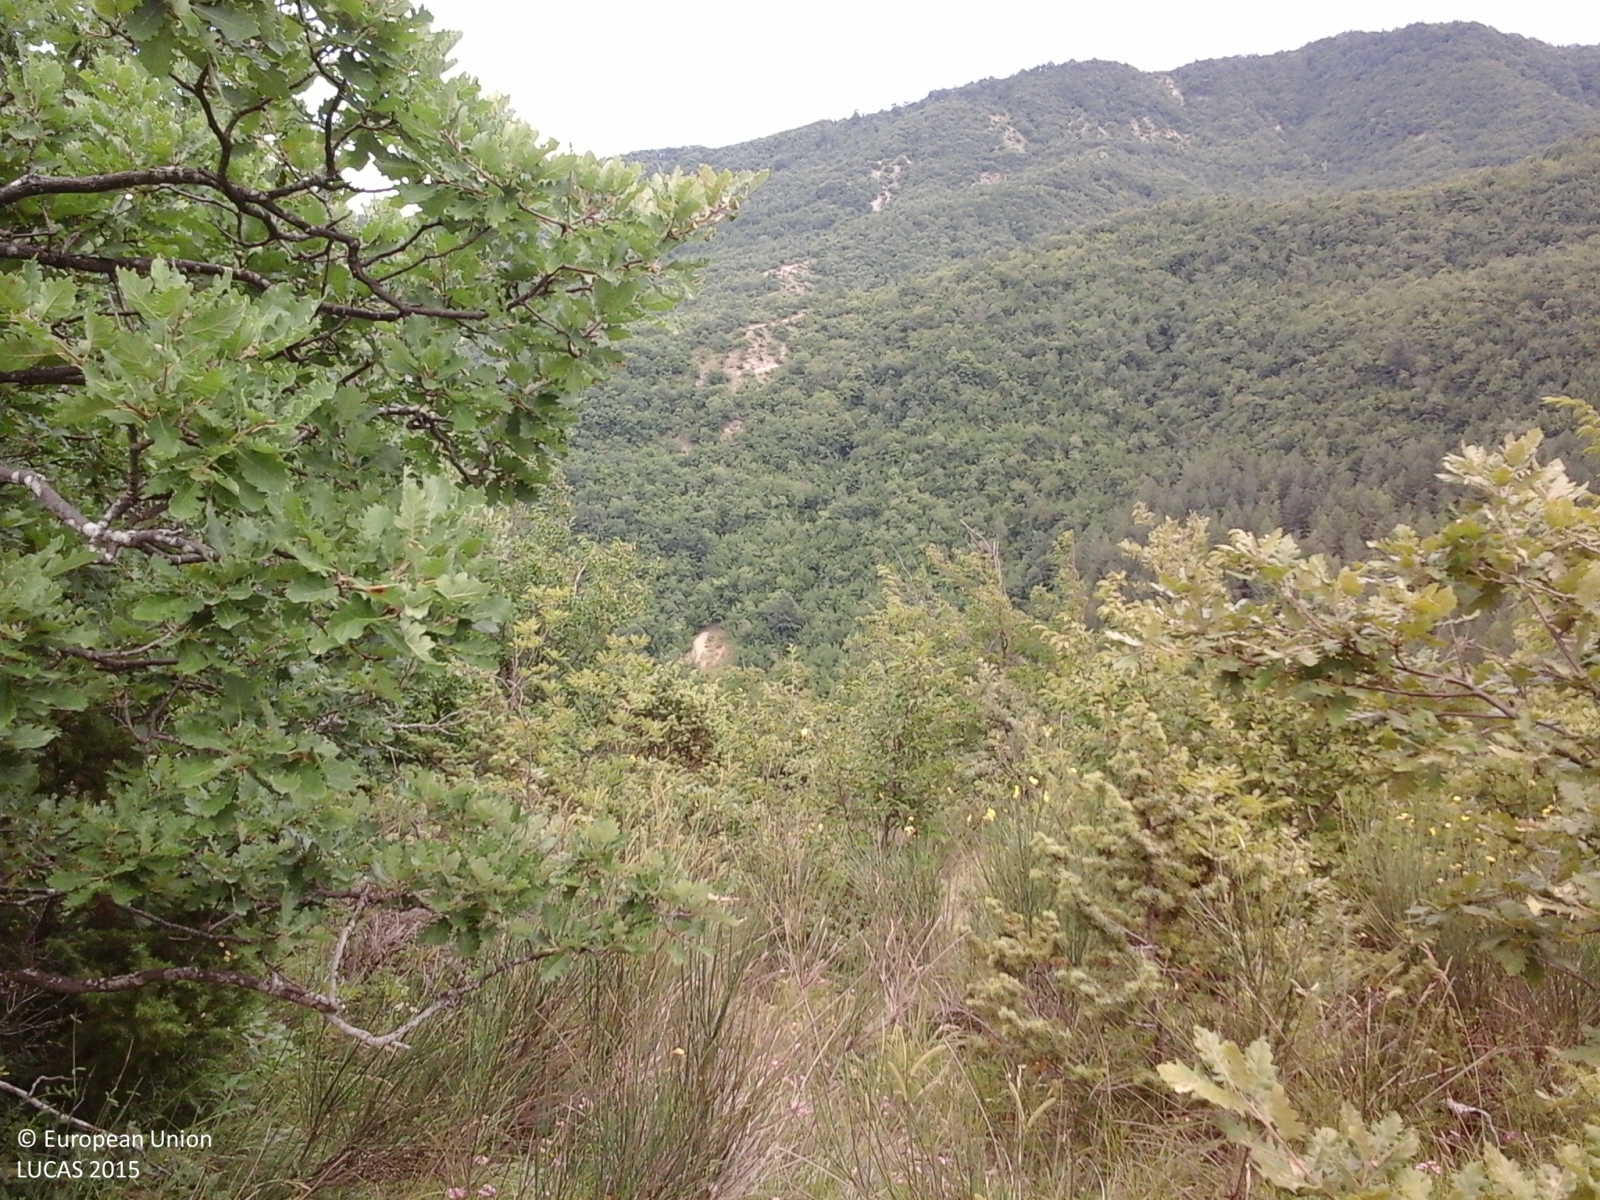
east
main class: Woodland
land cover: Broadleaved woodland
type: thermophilous deciduous forest
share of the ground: > 75 %
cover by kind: broadleaved forest trees 95 %, shrubs 5 %
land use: Semi-natural and natural areas not in use
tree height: > 5 m
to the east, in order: Broadleaved woodland; Tracks; Broadleaved woodland; Pine dominated coniferous woodland; Electric lines; Pine dominated coniferous woodland
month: June
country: IT
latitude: 44.1753
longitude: 11.6347
